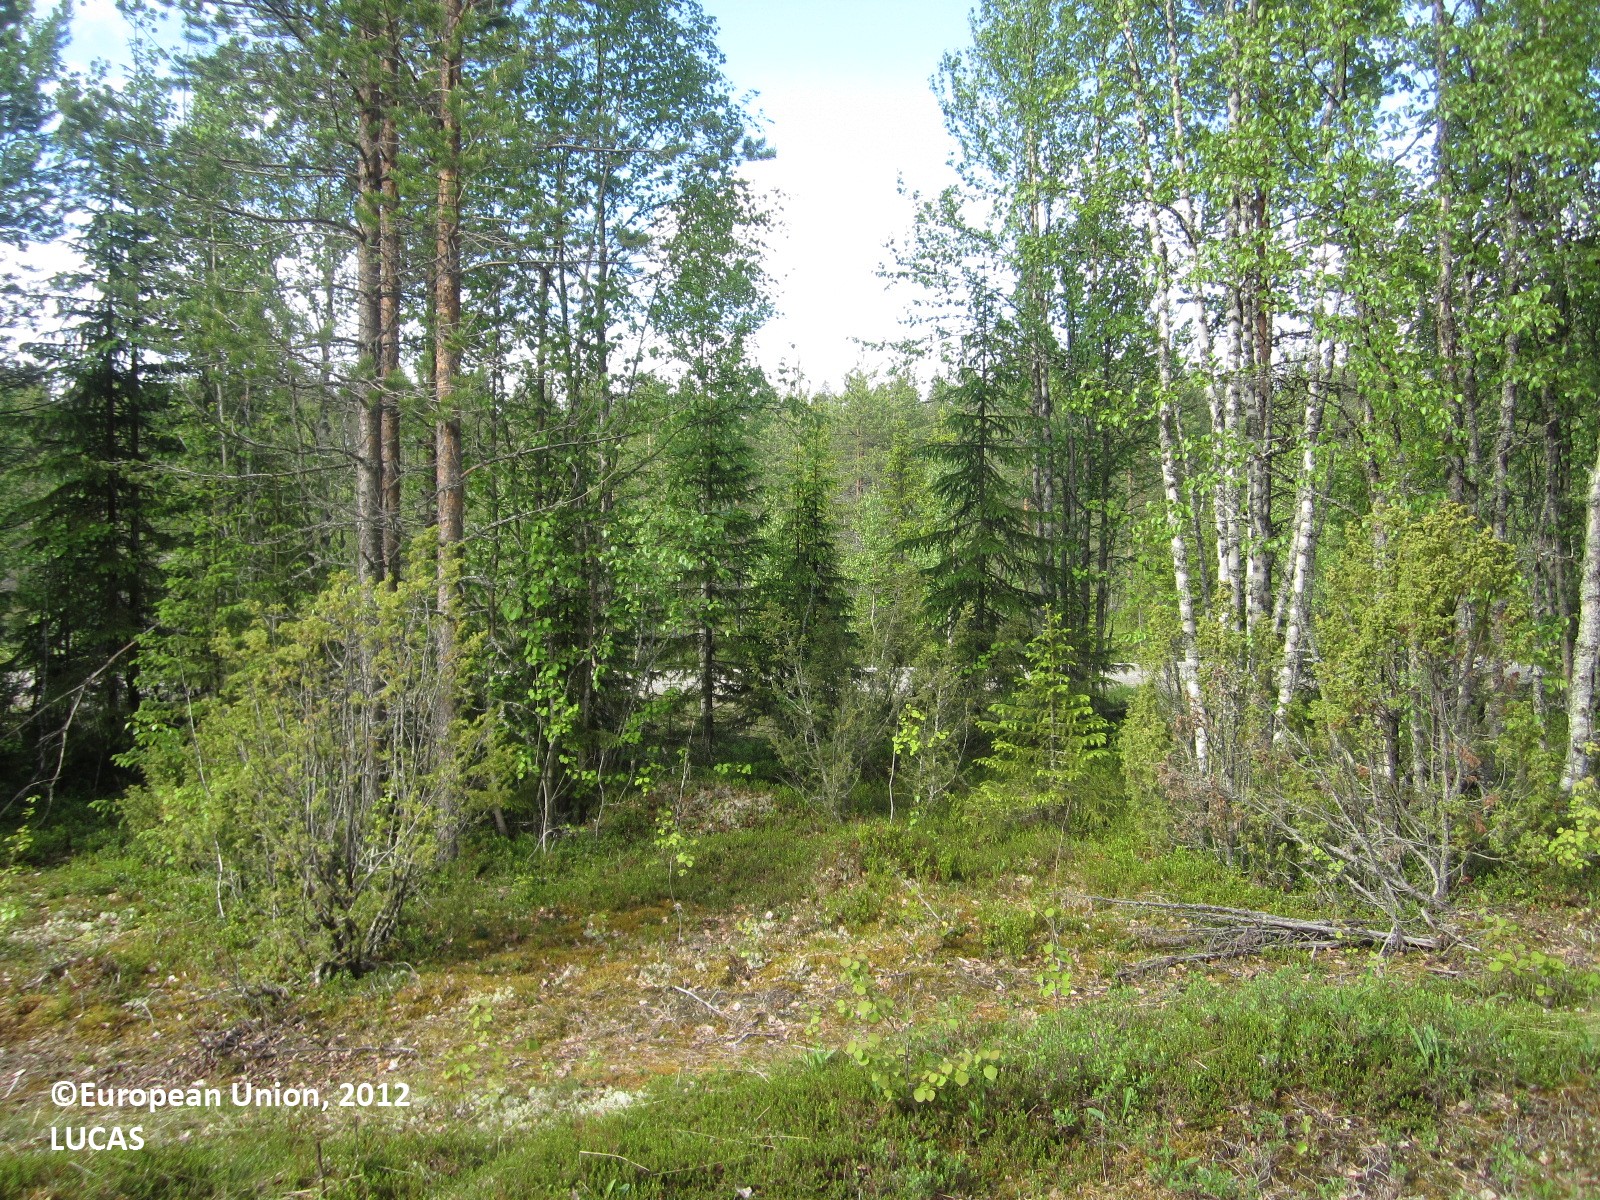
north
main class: Shrubland
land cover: Shrubland without tree cover
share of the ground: 50 - 75 %
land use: Energy production
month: June
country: FI
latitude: 64.6412
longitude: 30.0077
